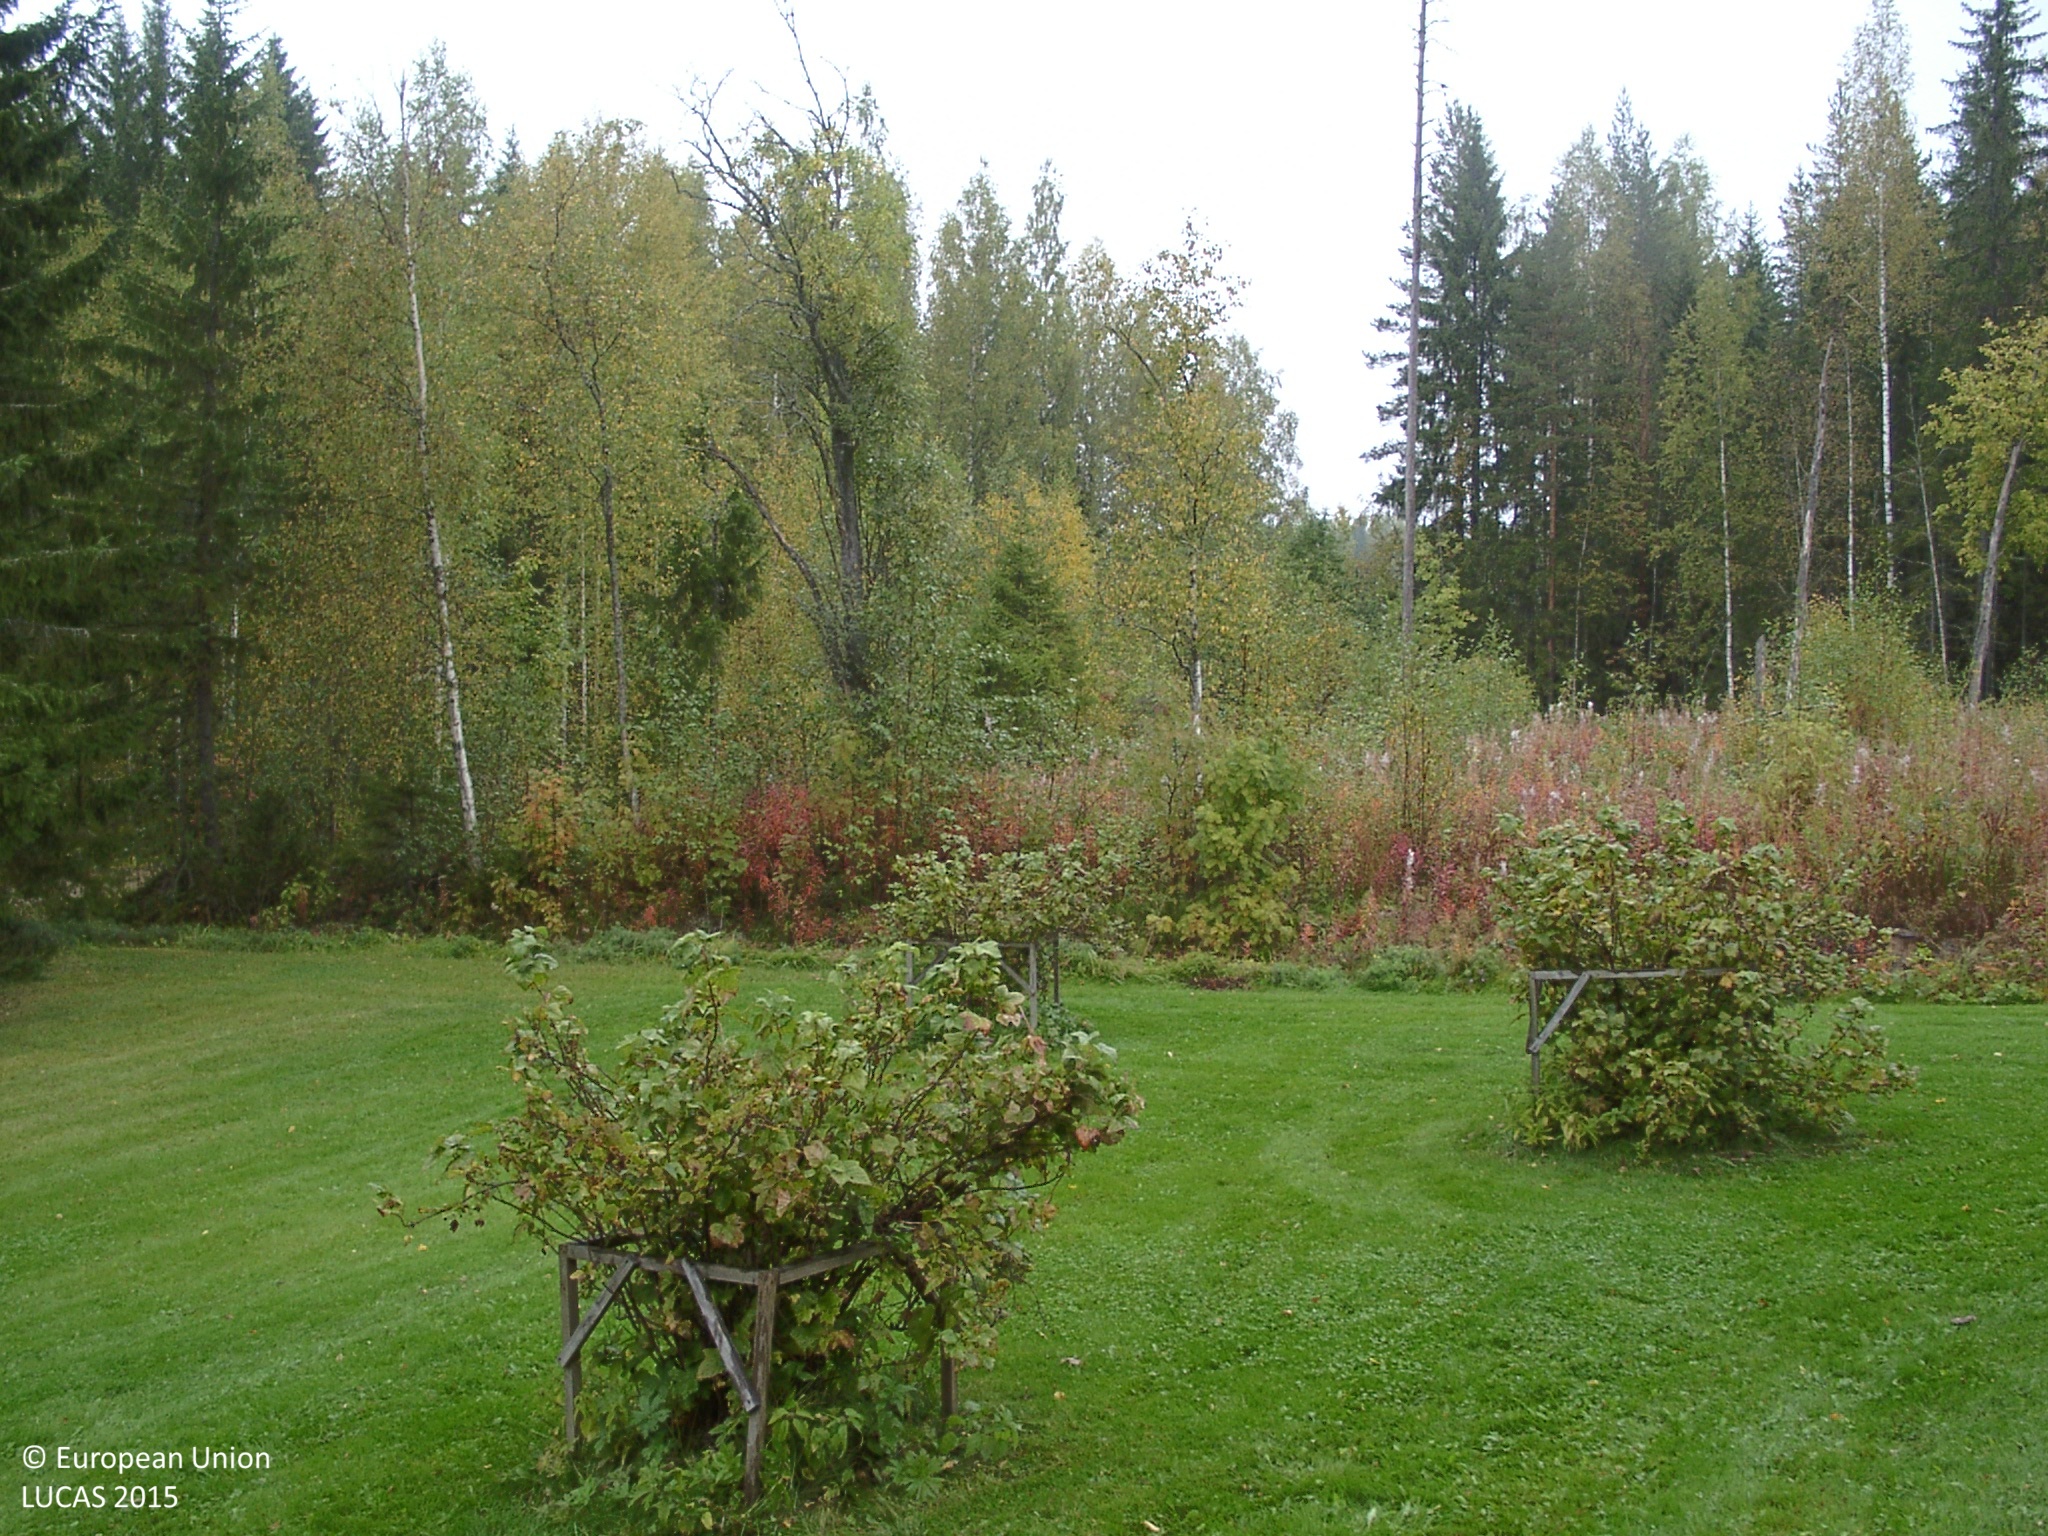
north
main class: Grassland
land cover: Grassland with sparse tree/shrub cover
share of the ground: > 75 %
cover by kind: herbaceous plants 85 %, broadleaved forest trees 5 %, shrubs 5 %, lichens and mosses 5 %
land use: Residential
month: September
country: FI
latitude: 62.5956
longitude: 25.6755
